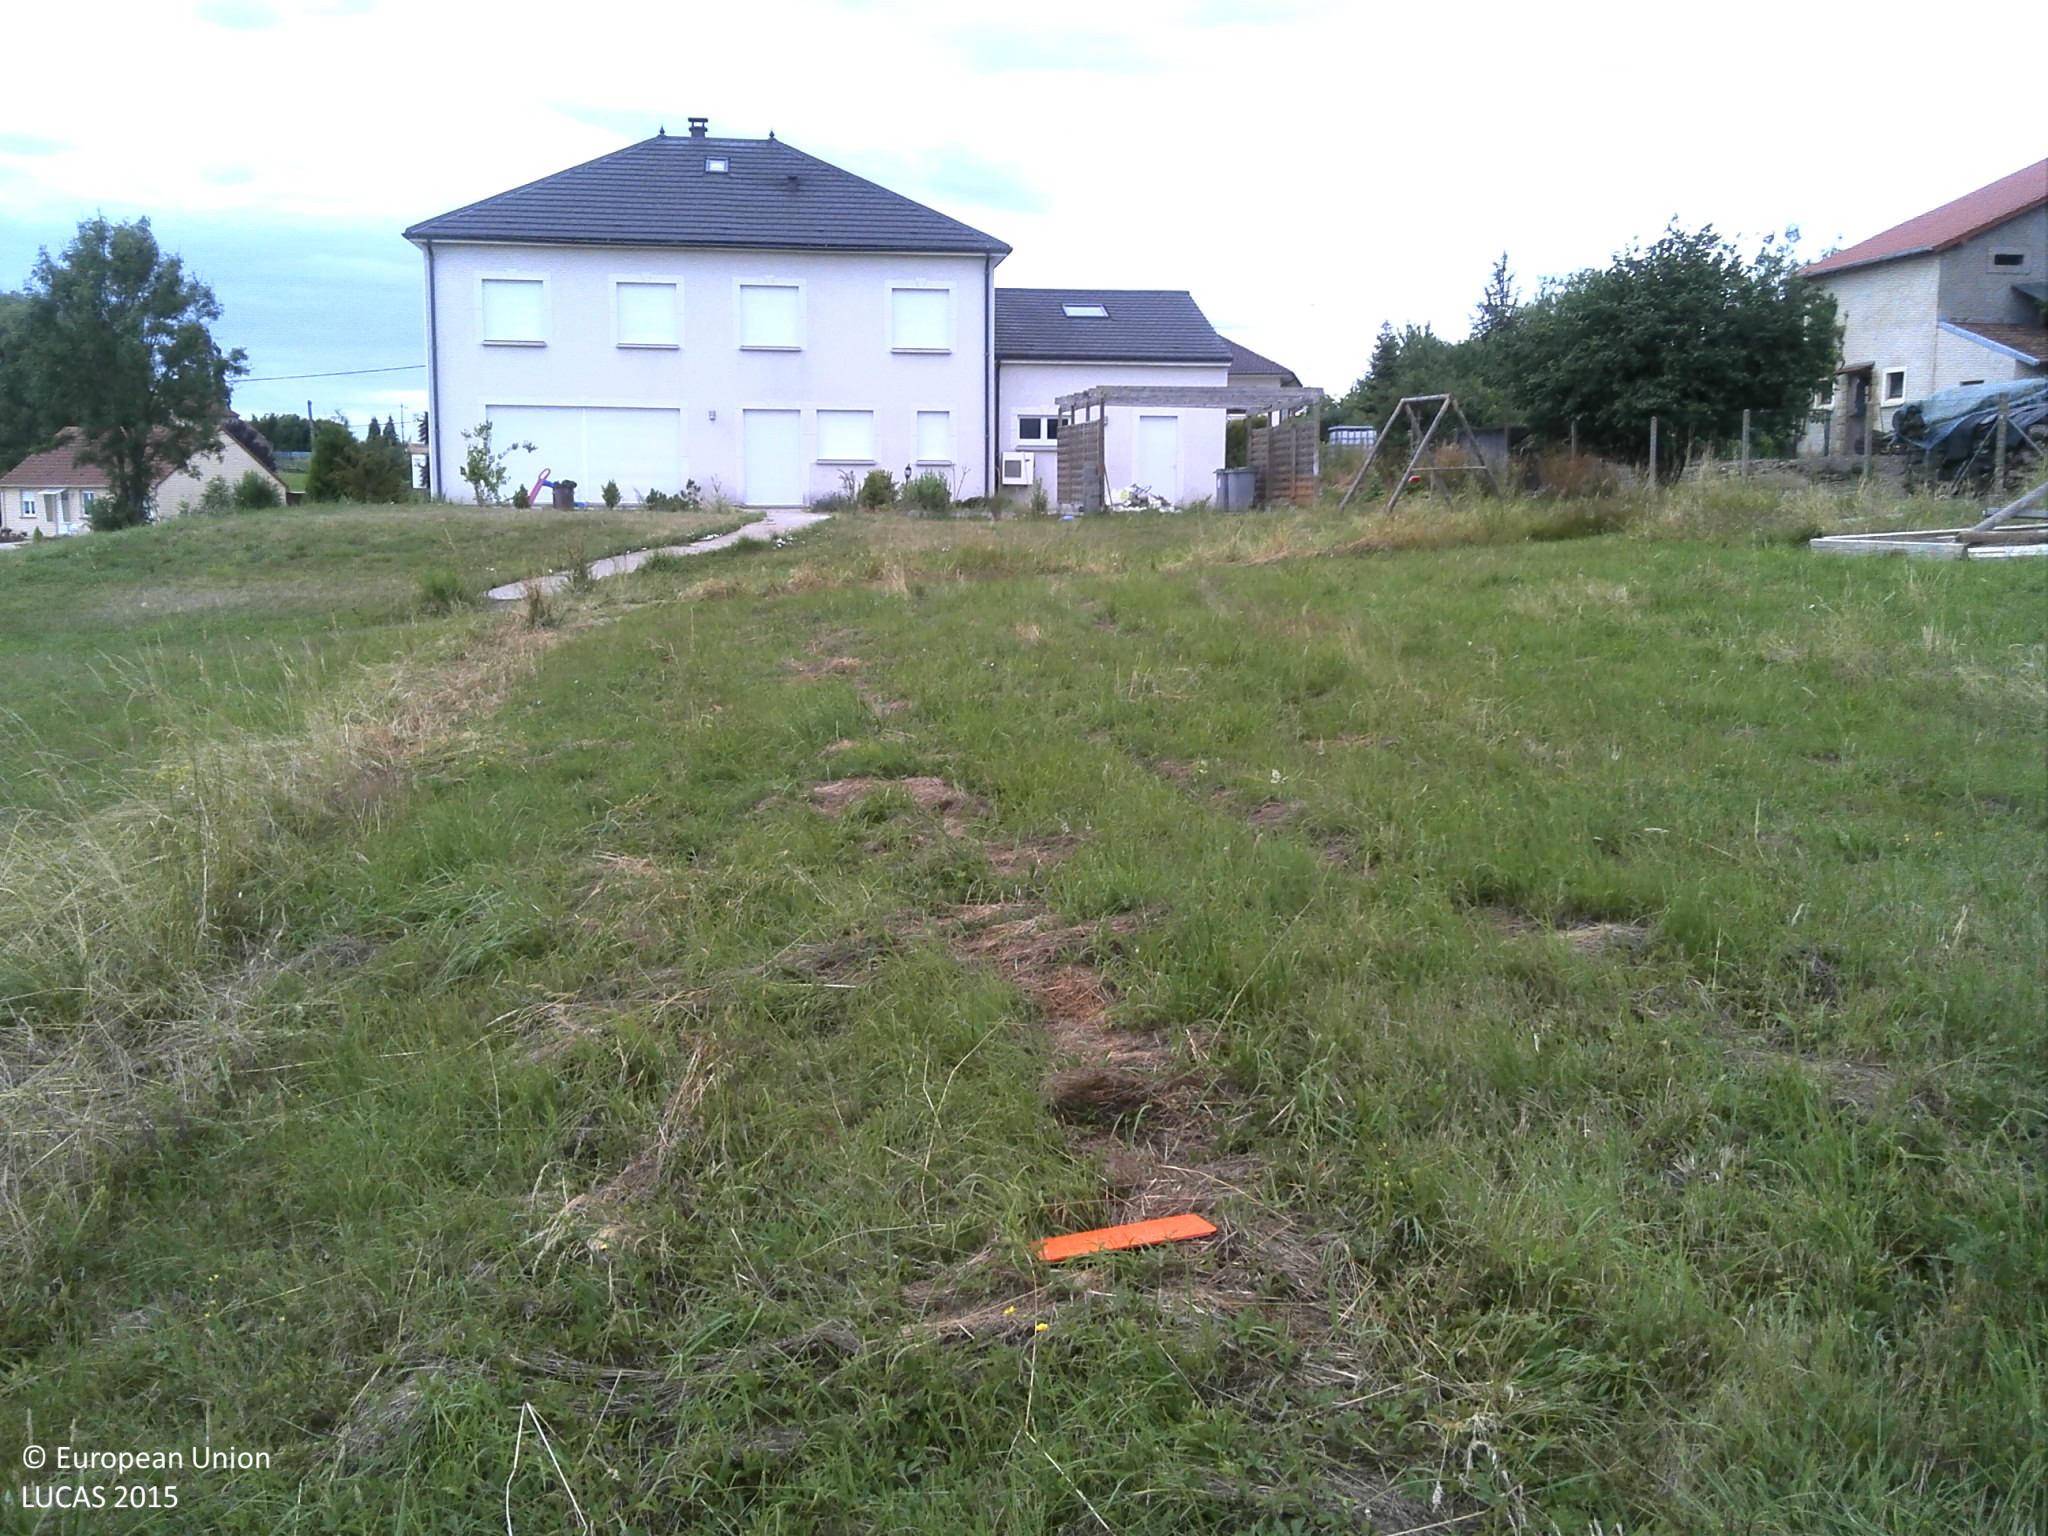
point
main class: Grassland
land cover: Grassland without tree/shrub cover
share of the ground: > 75 %
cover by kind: herbaceous plants 100 %
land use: Residential
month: July
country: FR
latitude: 49.3553
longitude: 6.4617
